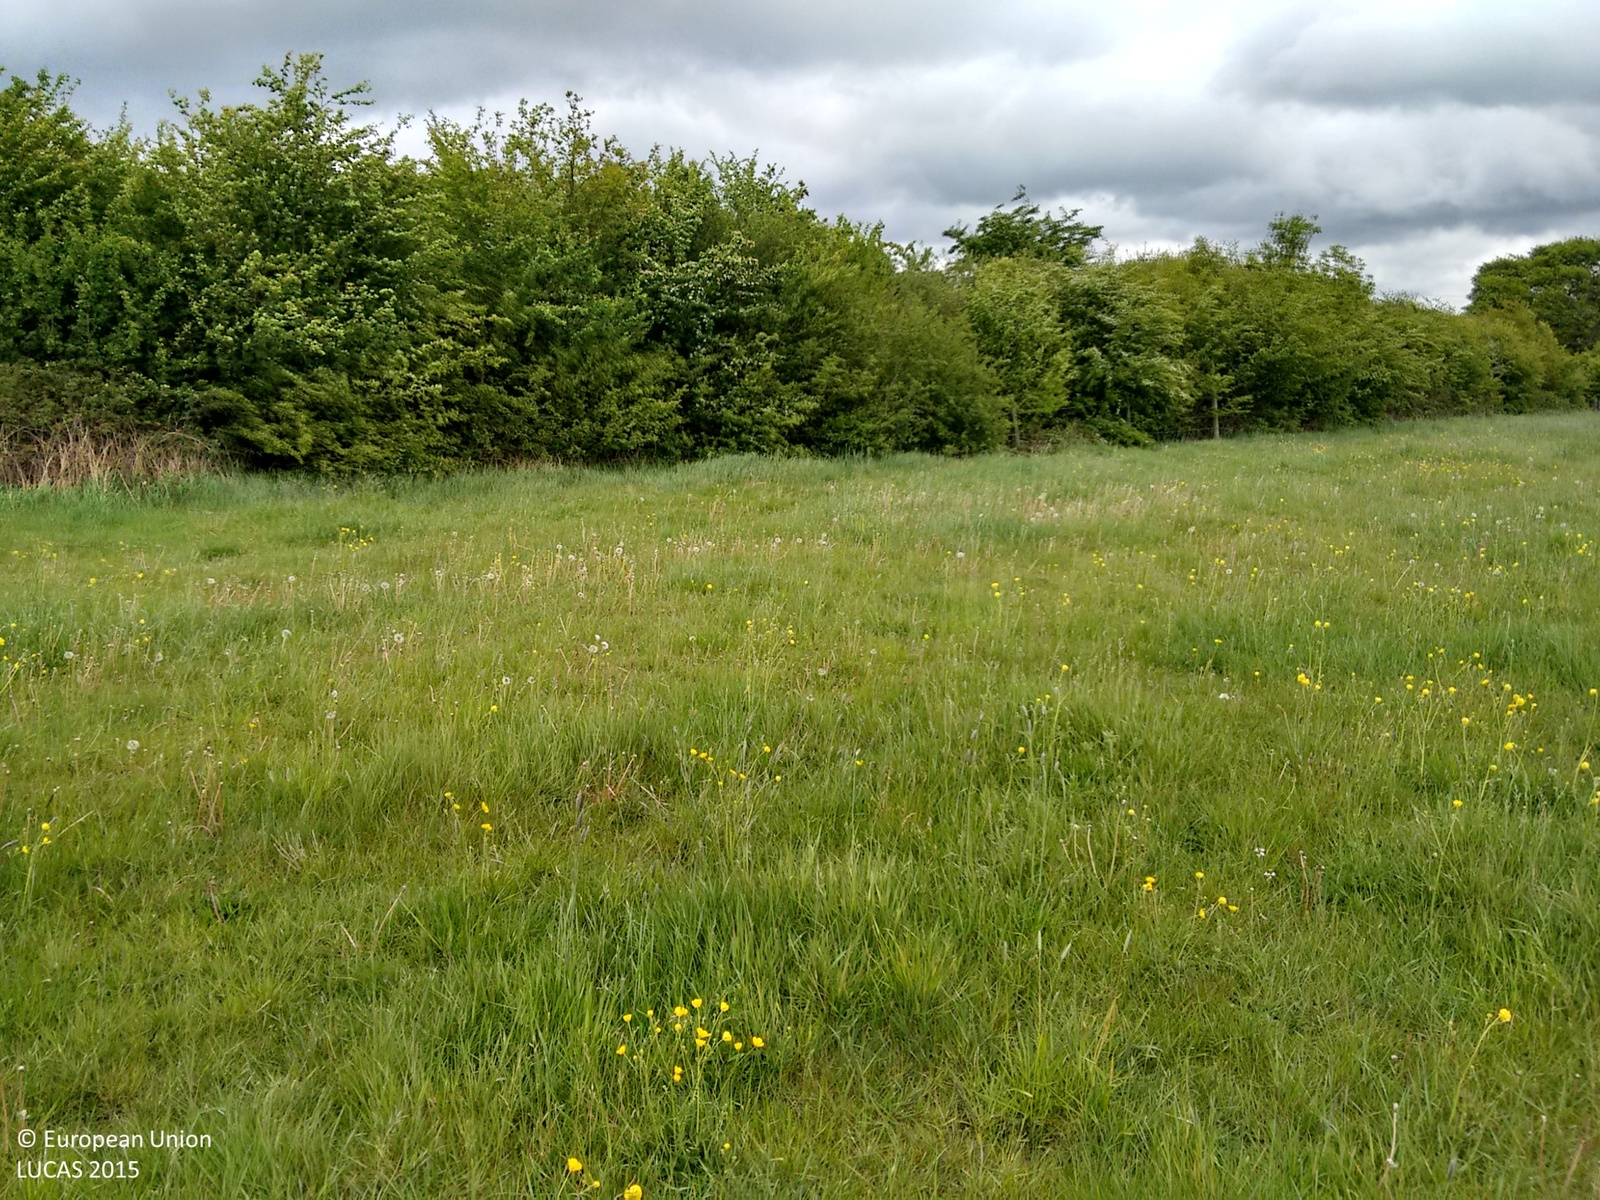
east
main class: Grassland
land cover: Grassland without tree/shrub cover
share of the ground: > 75 %
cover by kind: herbaceous plants 100 %
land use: Agriculture (excluding fallow land and kitchen gardens)
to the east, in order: Grassland without tree/shrub cover; Abandoned hedges; Ditches and canals; Abandoned hedges; Grassland without tree/shrub cover; Electric lines; Grassland without tree/shrub cover
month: May
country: GB
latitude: 53.6397
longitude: -1.0398
